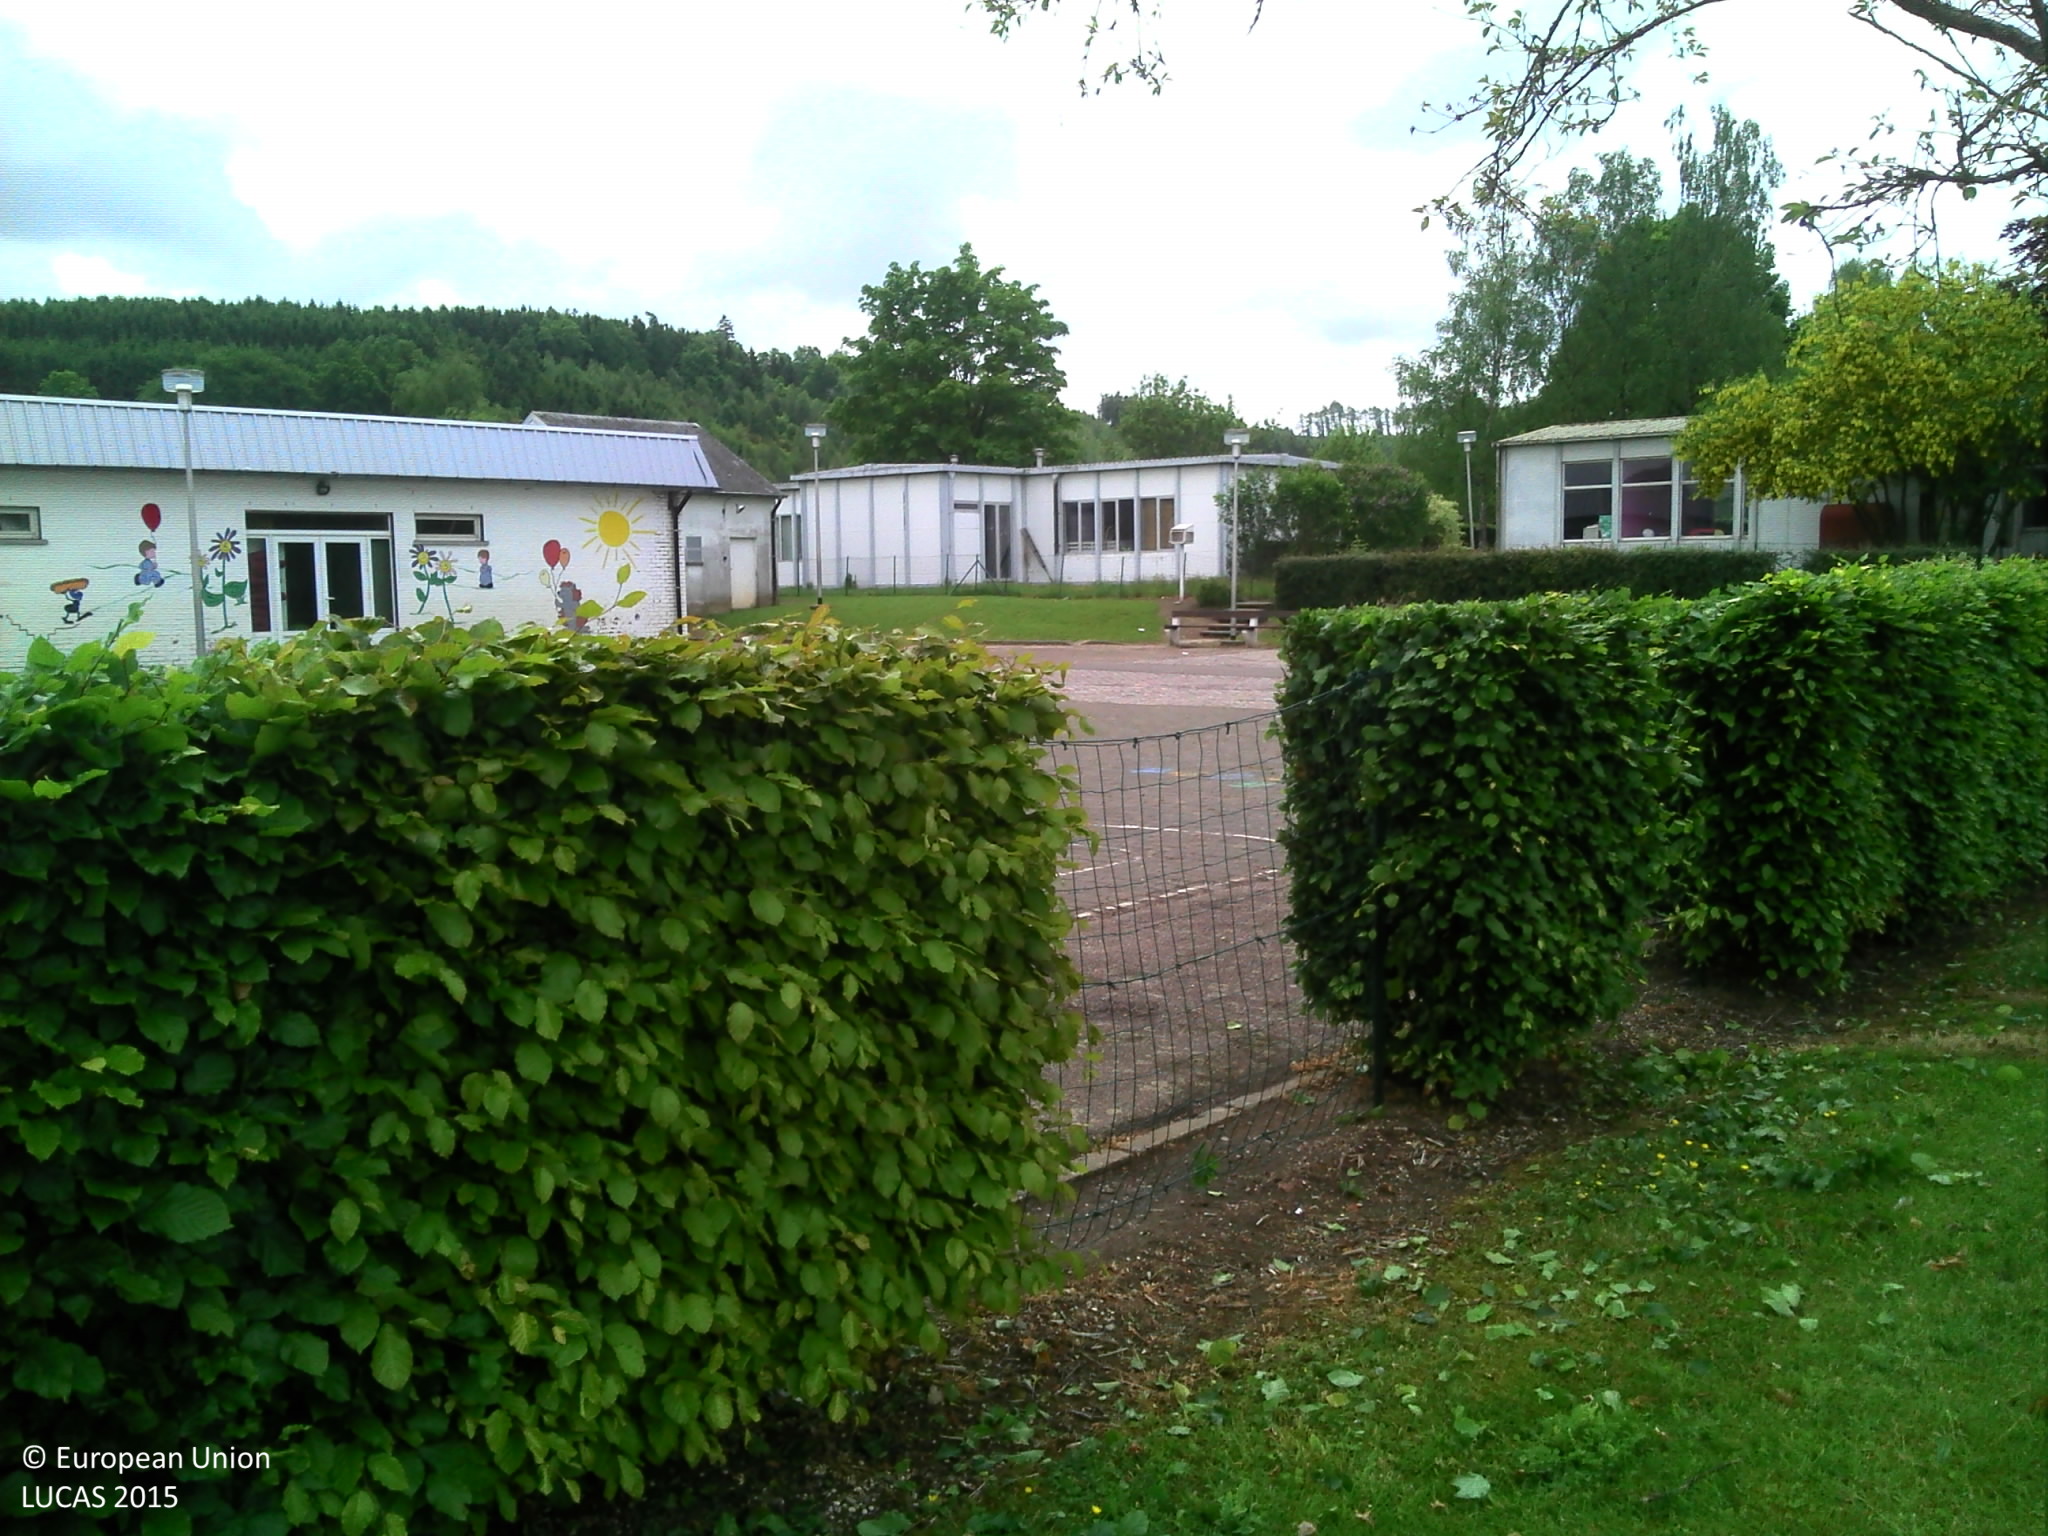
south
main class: Grassland
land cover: Grassland without tree/shrub cover
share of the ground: > 75 %
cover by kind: herbaceous plants 100 %
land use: Community services
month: June
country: BE
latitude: 50.2871
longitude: 5.8023
